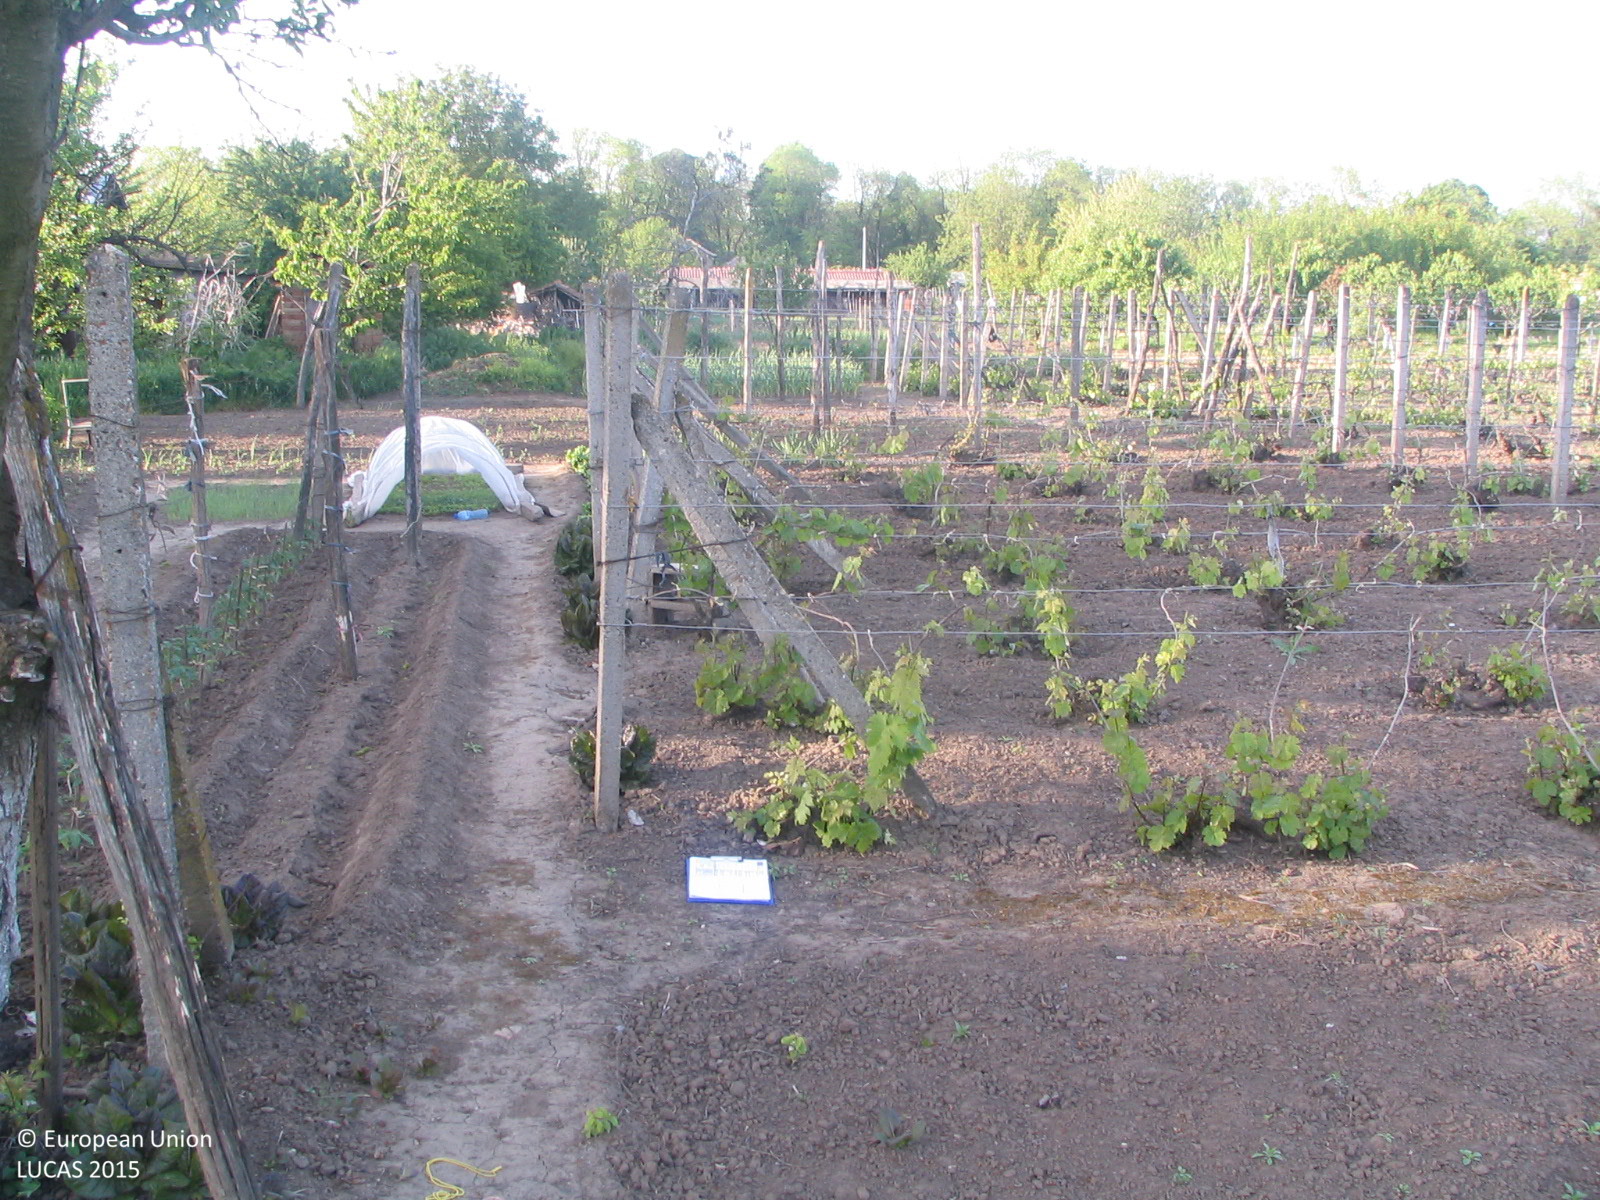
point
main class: Cropland
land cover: Dry pulses
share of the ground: < 10 %
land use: Kitchen garden
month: May
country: BG
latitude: 43.6694
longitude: 24.0070
